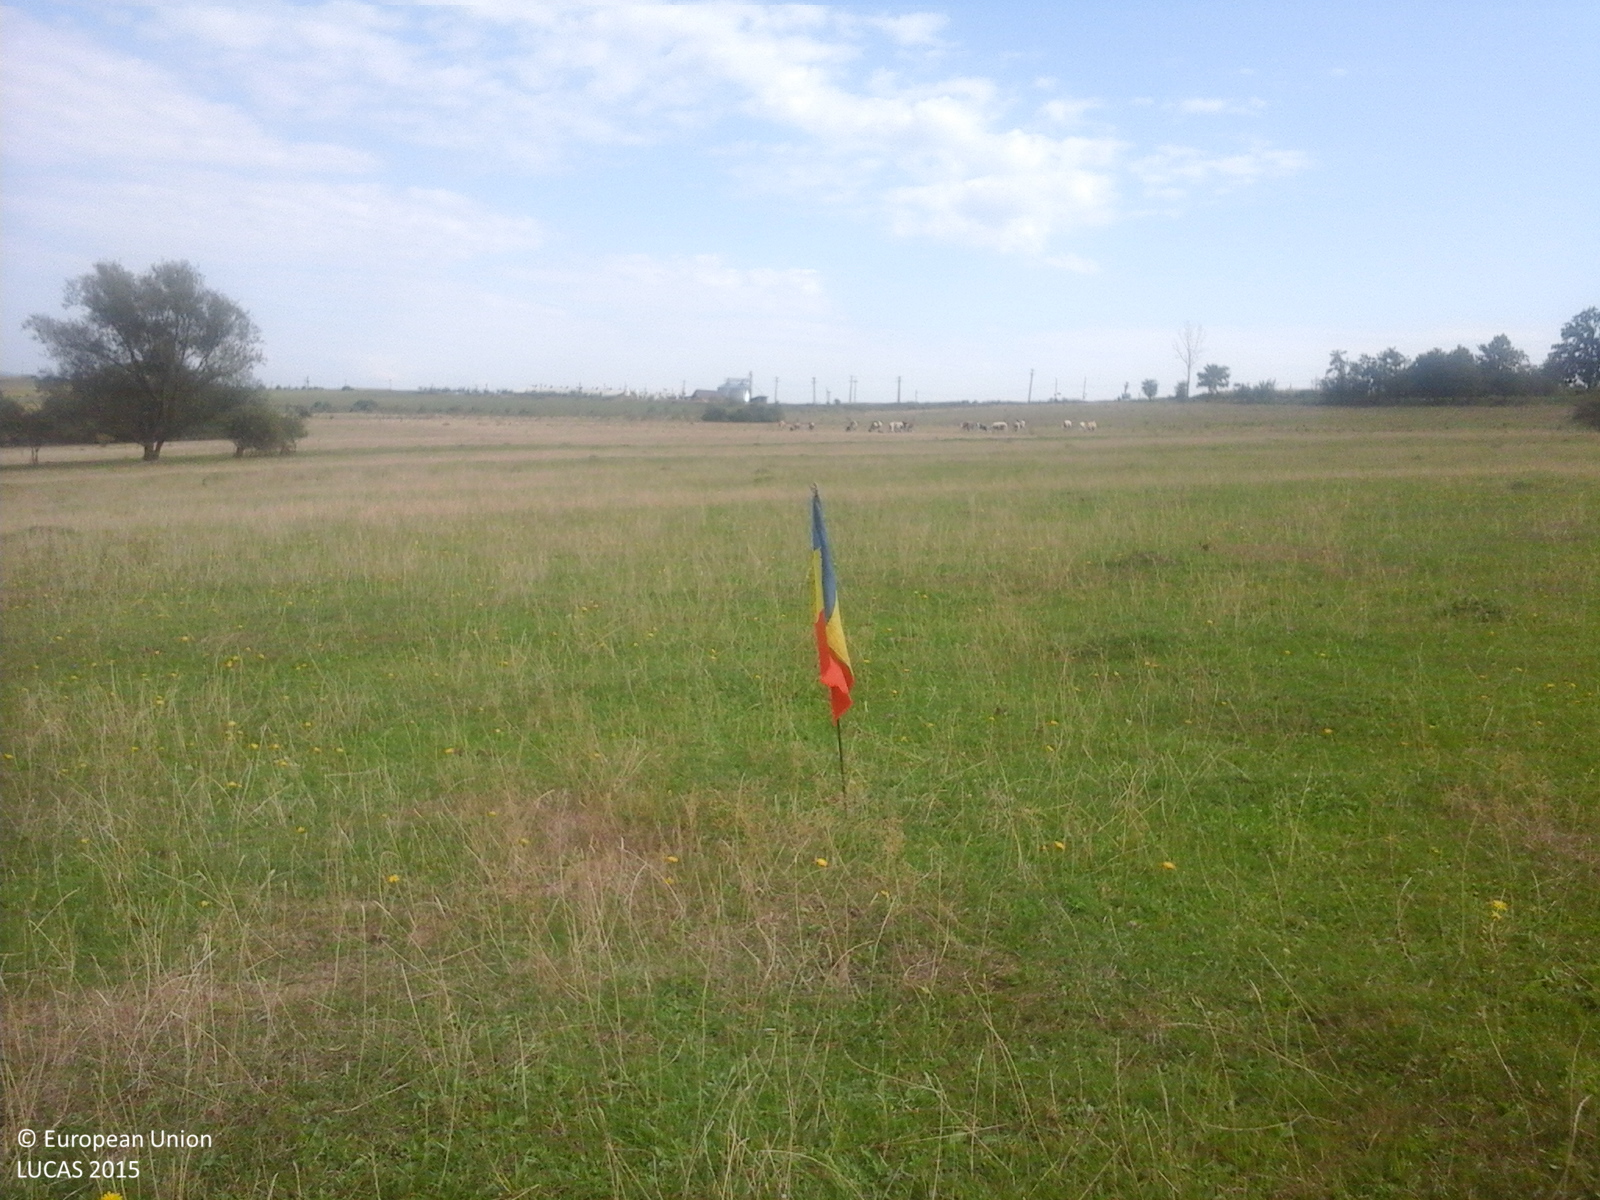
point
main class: Grassland
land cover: Grassland without tree/shrub cover
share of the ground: > 75 %
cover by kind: herbaceous plants 100 %
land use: Agriculture (excluding fallow land and kitchen gardens)
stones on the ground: < 10 %
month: September
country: RO
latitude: 47.3567
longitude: 22.8644
